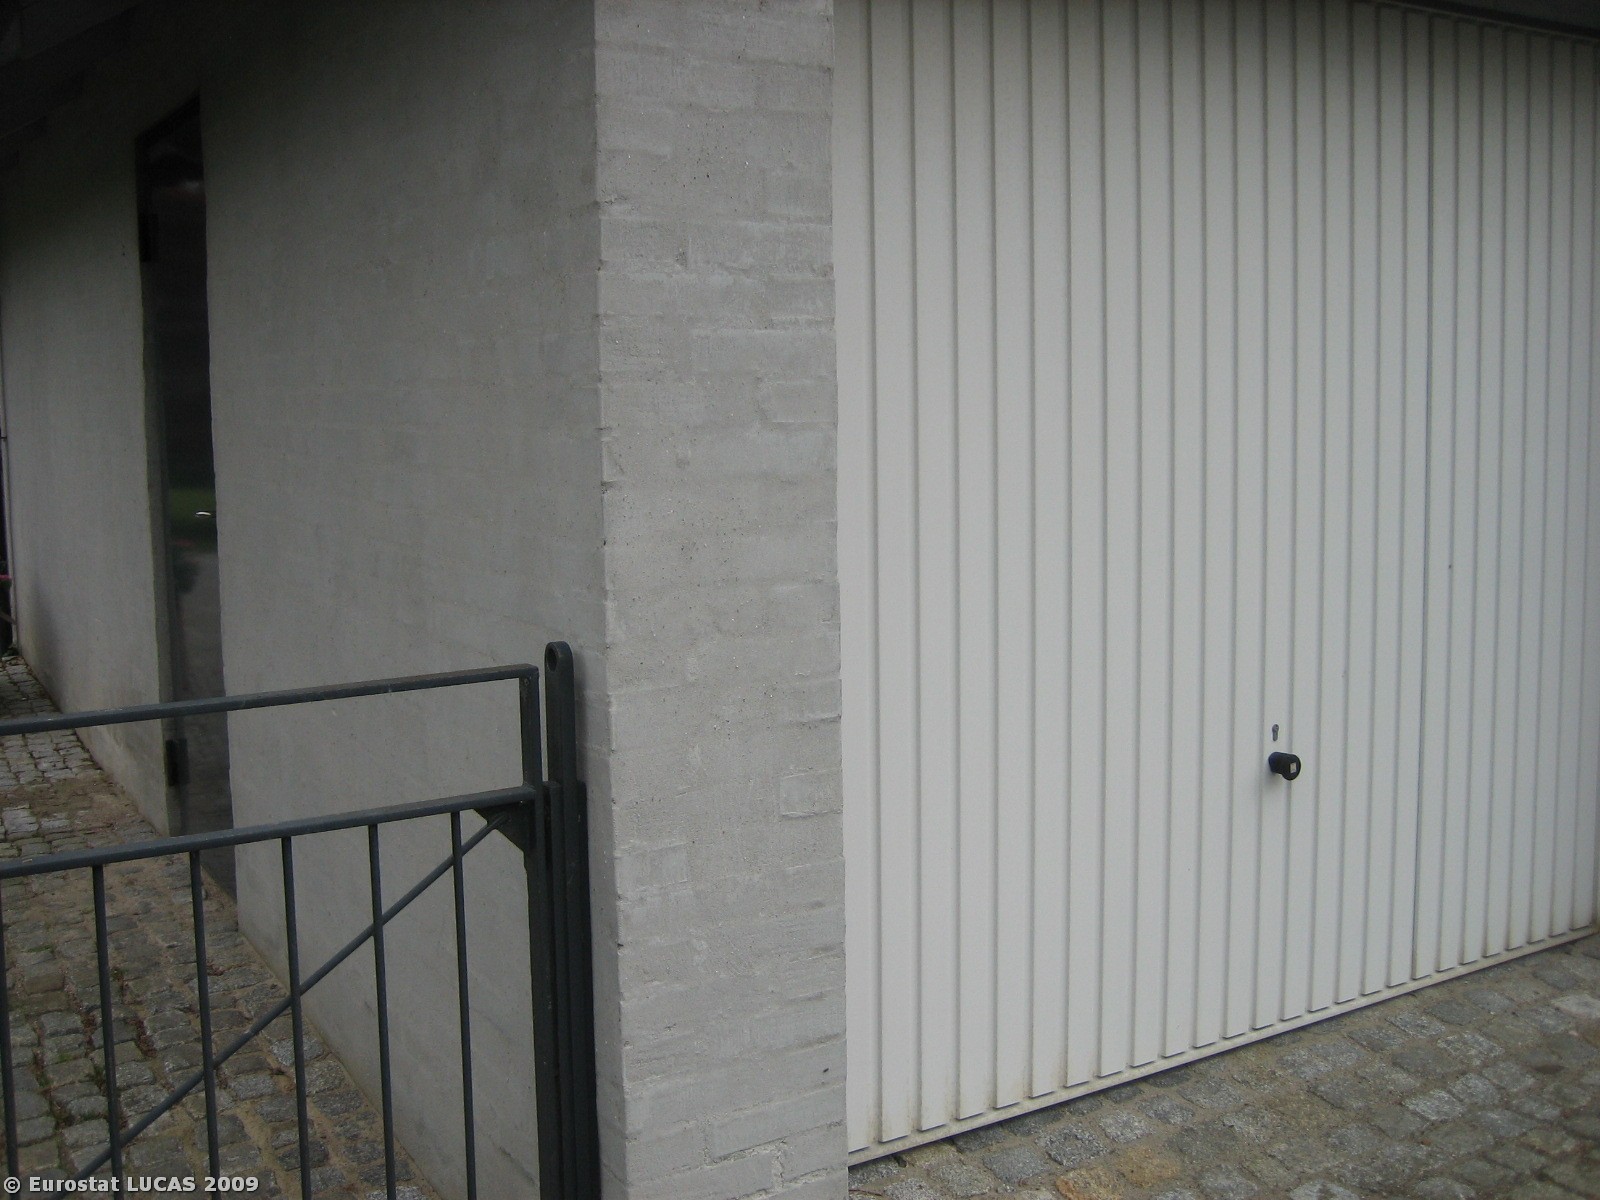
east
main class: Grassland
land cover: Grassland without tree/shrub cover
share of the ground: > 75 %
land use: Residential
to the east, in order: Grassland without tree/shrub cover; Broadleaved woodland; Grassland without tree/shrub cover; Artificial constructions in urban areas; Fences; Other structural elements; Grass margins; Other structural elements; Paved roads, cycling and walking lanes; Other structural elements; Lines of trees; Grassland without tree/shrub cover; Other structural elements; Grassland without tree/shrub cover; Rock outcrops; Transitional water bodies
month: June
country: DK
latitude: 56.1336
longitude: 10.2089
